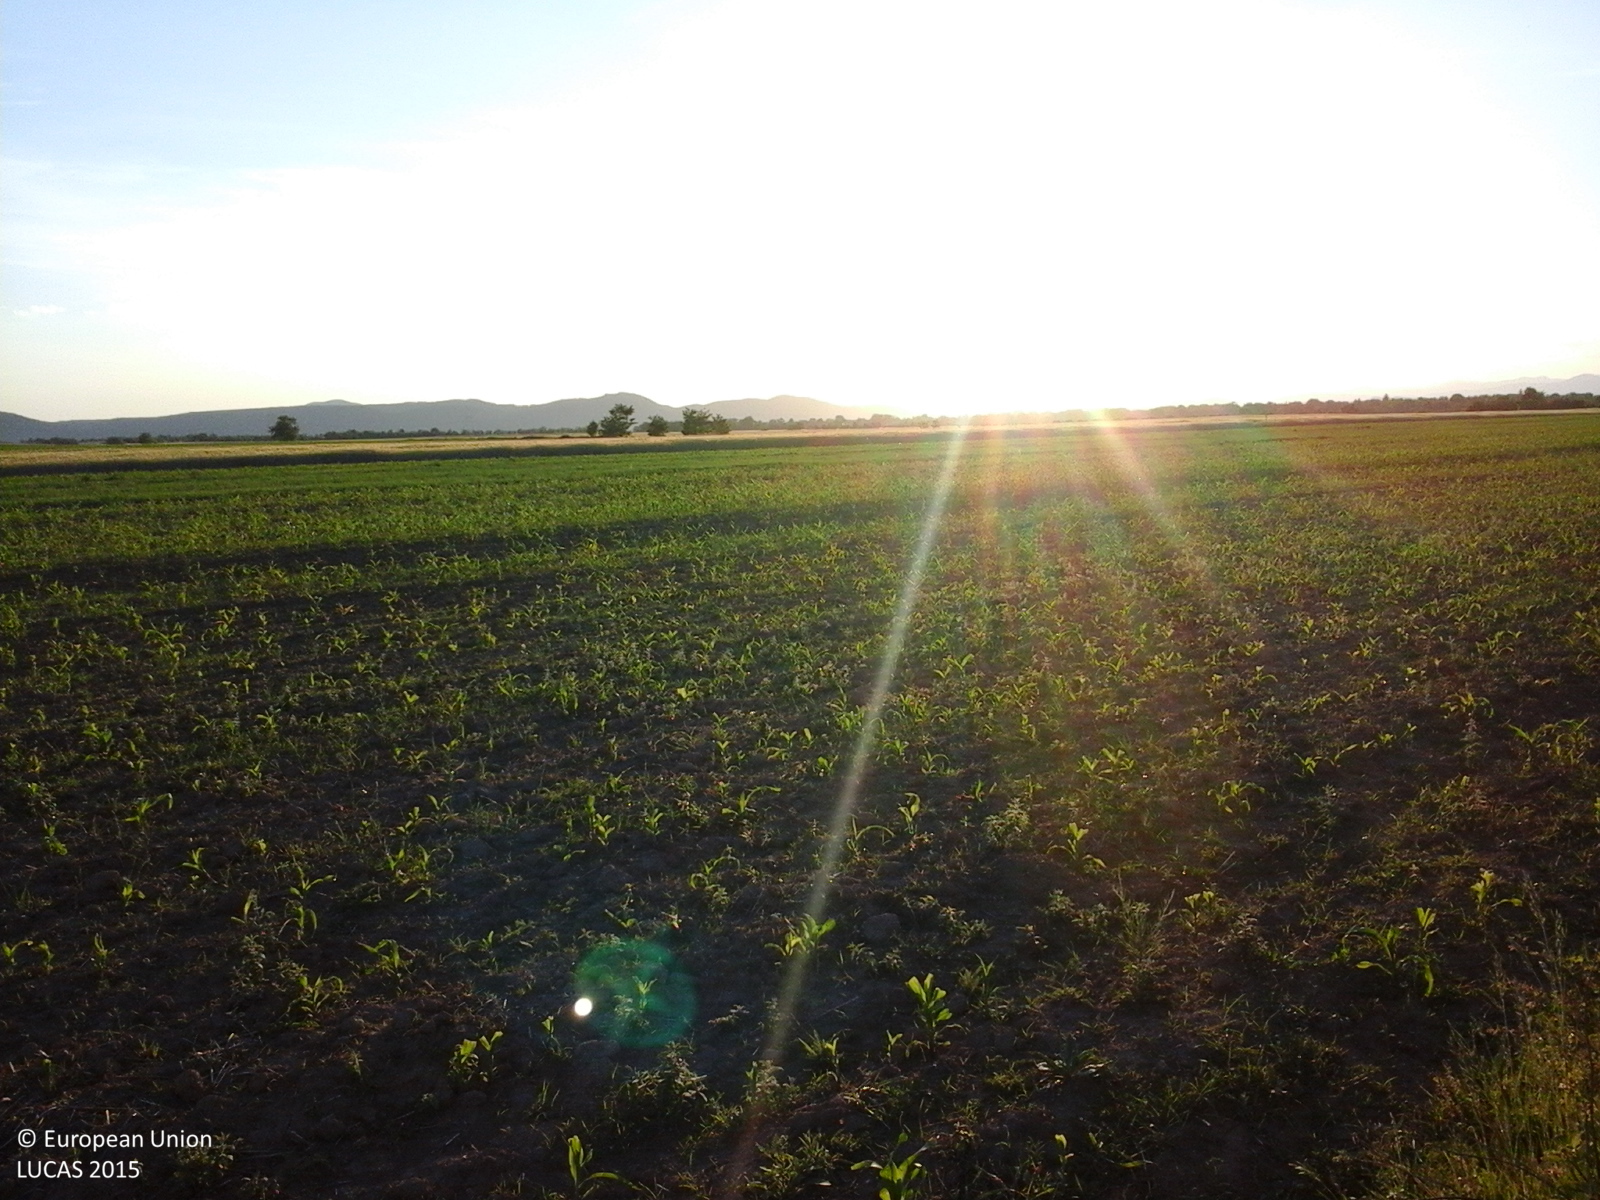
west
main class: Grassland
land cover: Grassland without tree/shrub cover
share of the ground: > 75 %
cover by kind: herbaceous plants 100 %
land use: Agriculture (excluding fallow land and kitchen gardens)
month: June
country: RO
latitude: 45.0732
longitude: 25.8169
